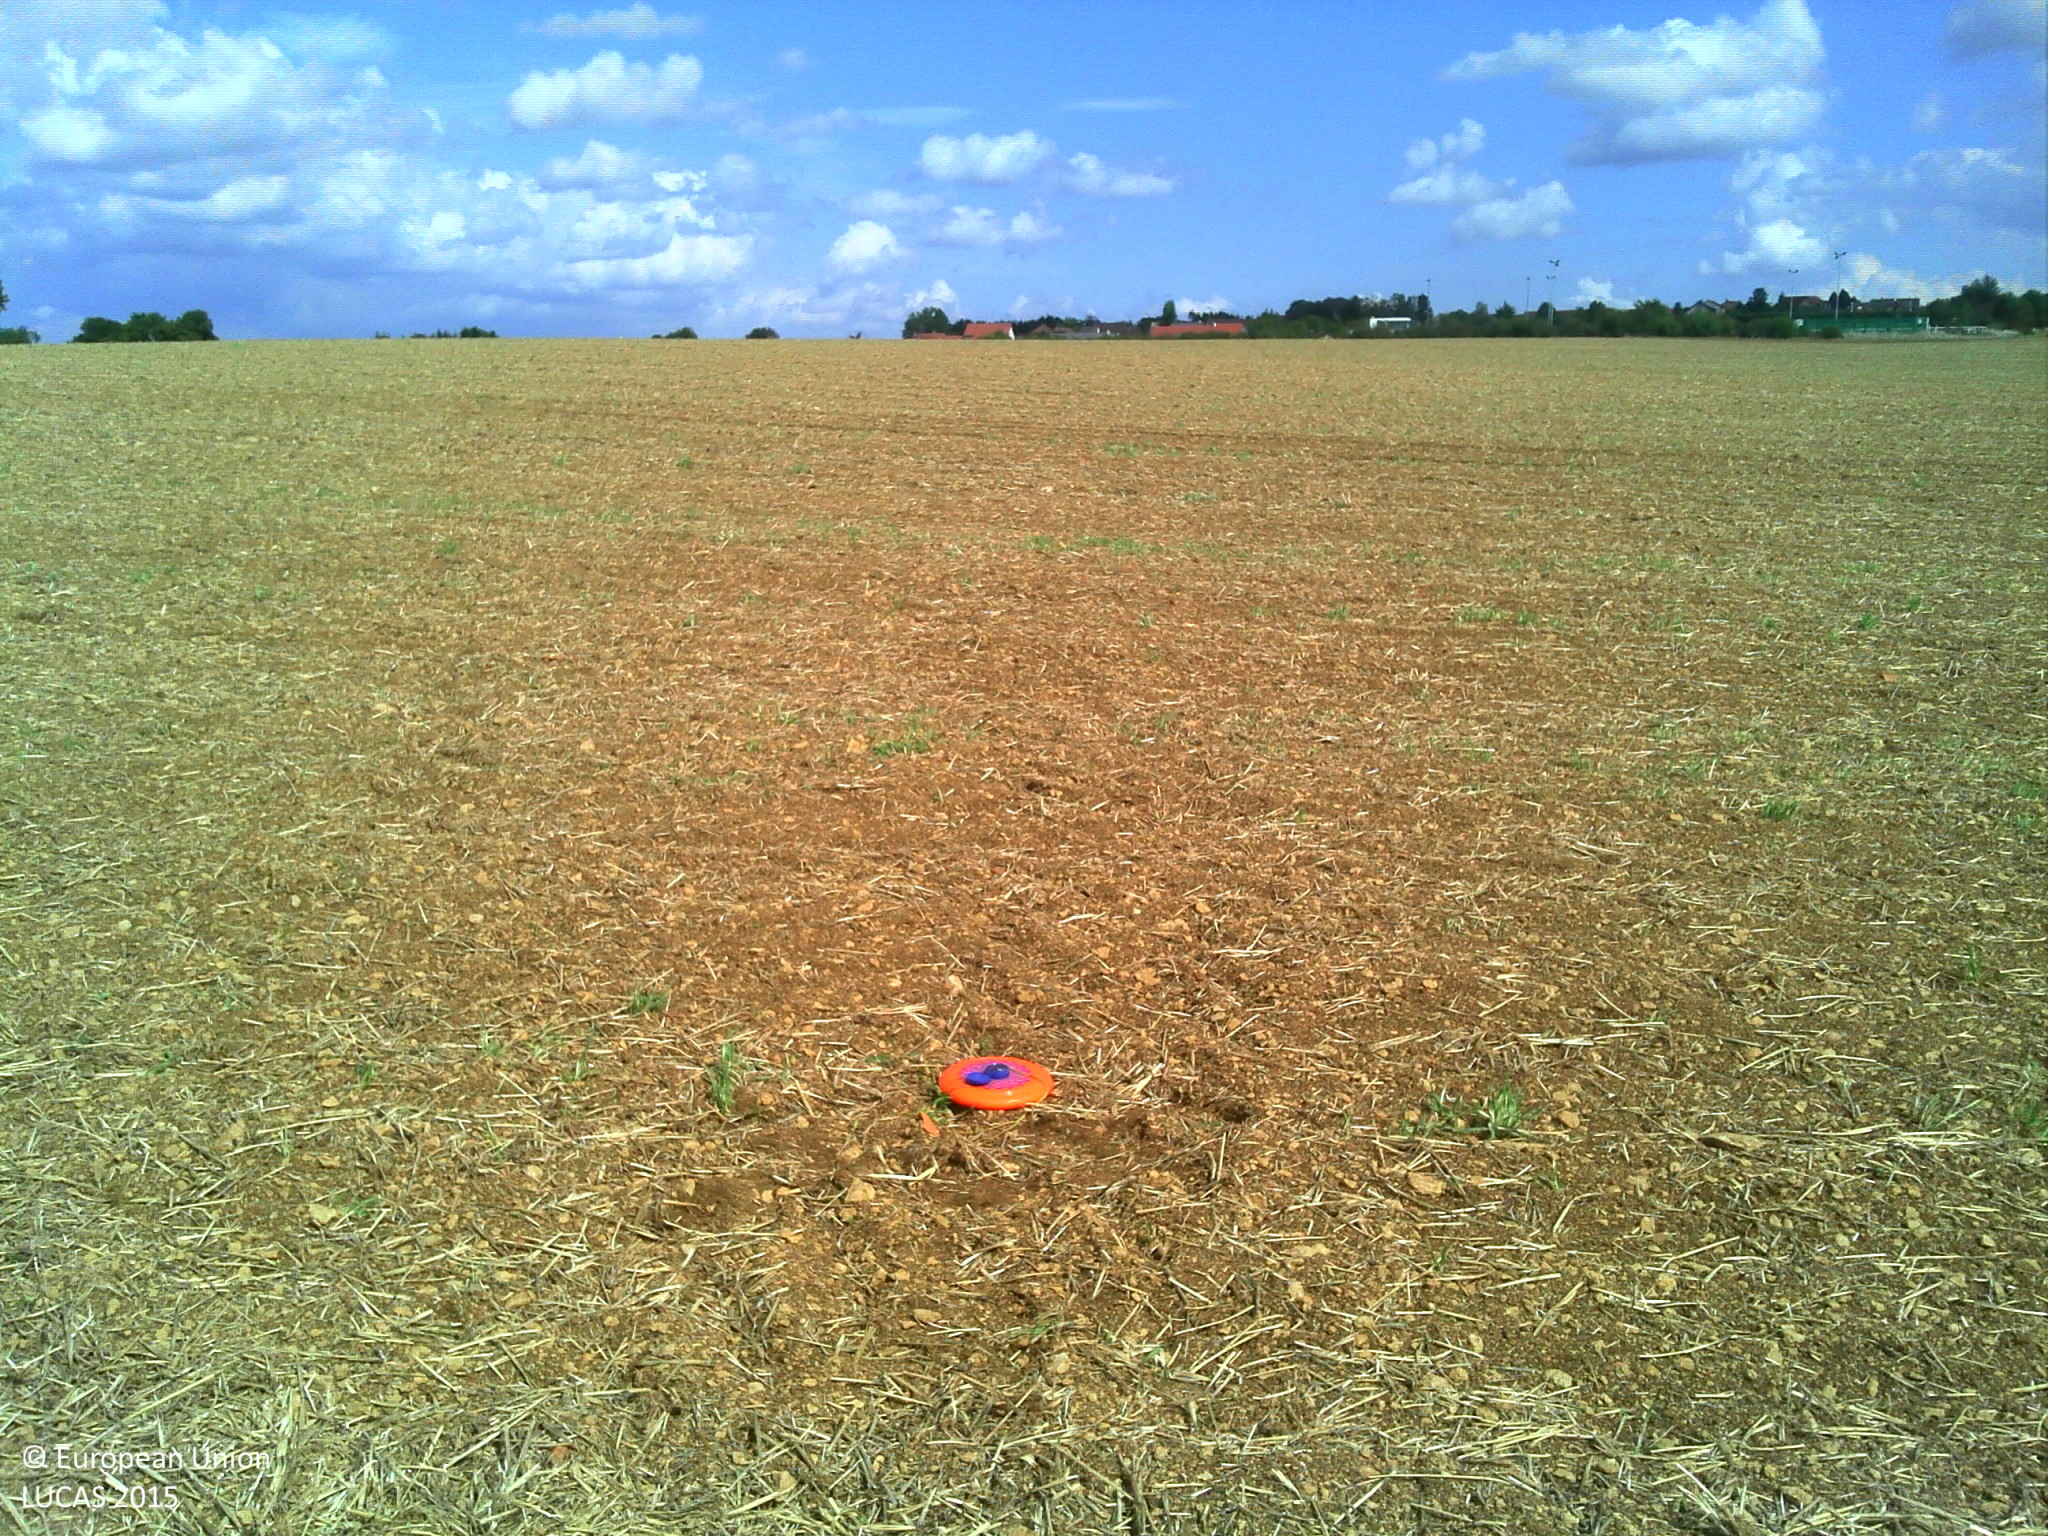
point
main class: Cropland
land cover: Common wheat
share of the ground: < 10 %
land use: Agriculture (excluding fallow land and kitchen gardens)
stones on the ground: 10 - 25 %
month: September
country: FR
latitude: 49.1392
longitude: 5.9284
